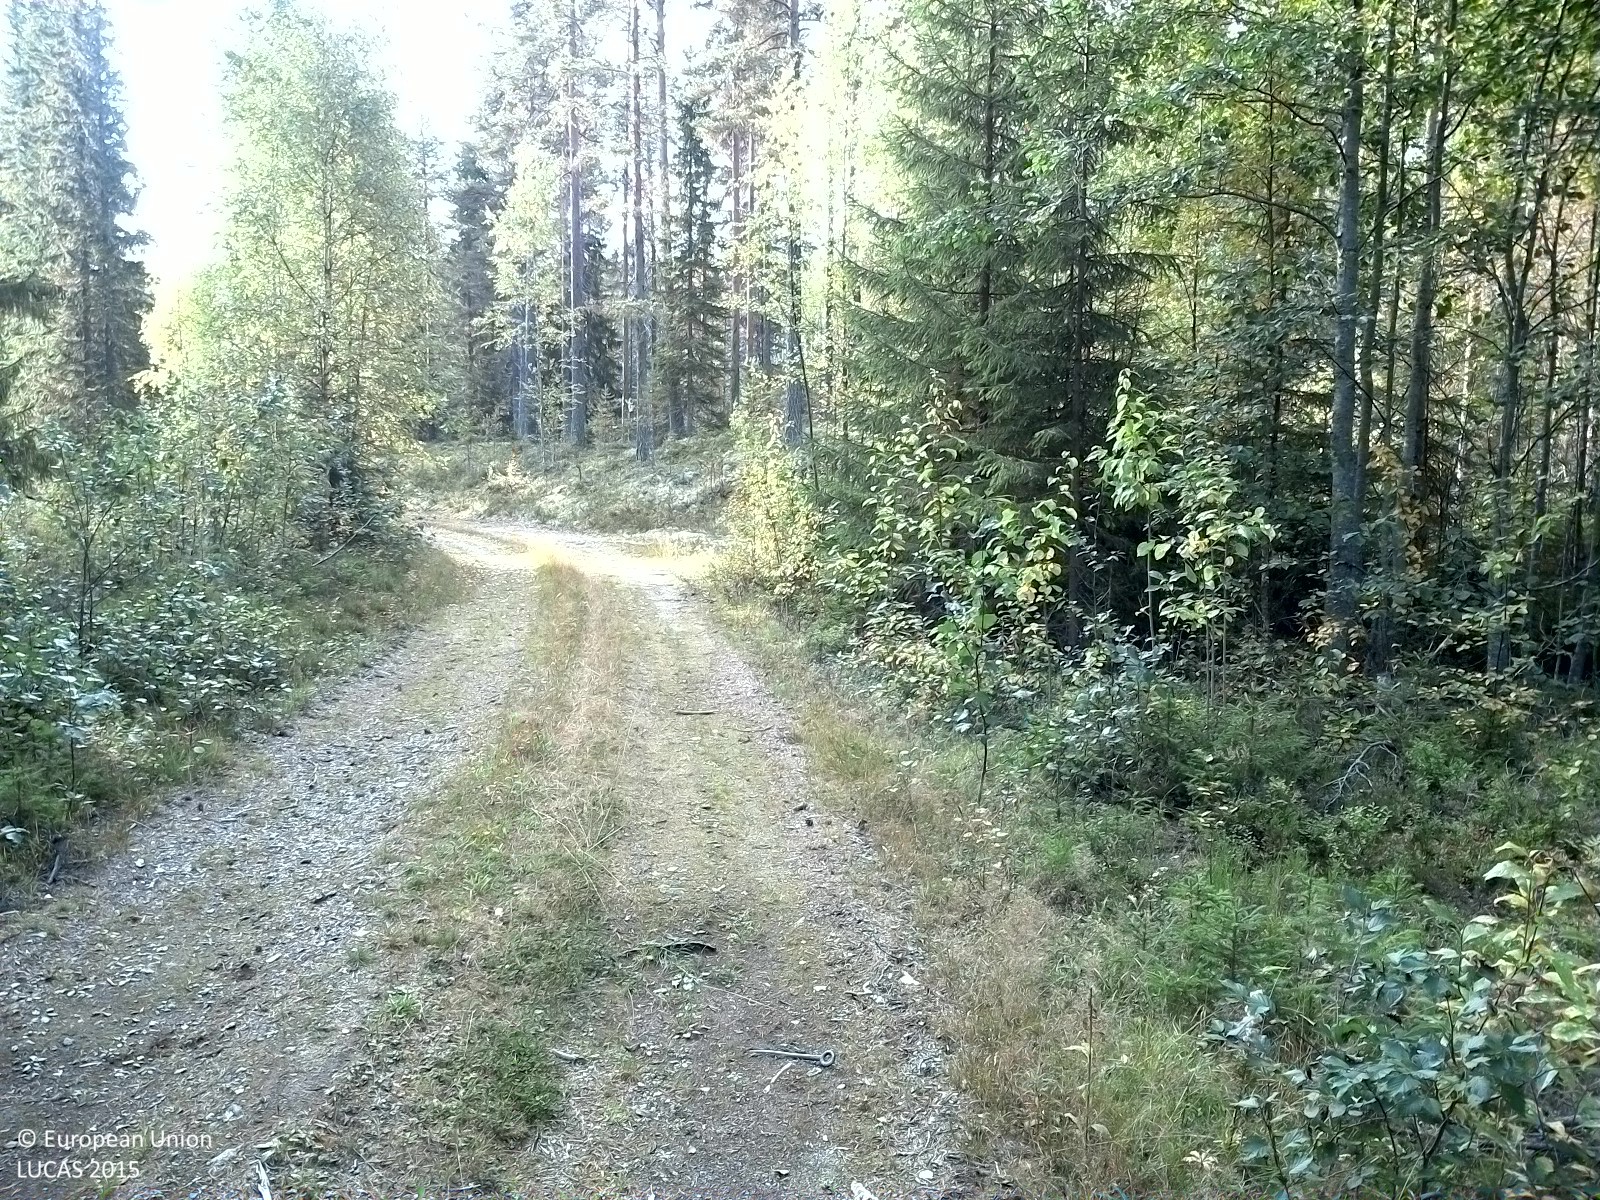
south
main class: Woodland
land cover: Spruce dominated mixed woodland
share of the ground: > 75 %
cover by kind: coniferous forest trees 40 %, broadleaved forest trees 35 %, shrubs 25 %
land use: Forestry
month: September
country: SE
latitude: 62.6035
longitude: 16.3876
